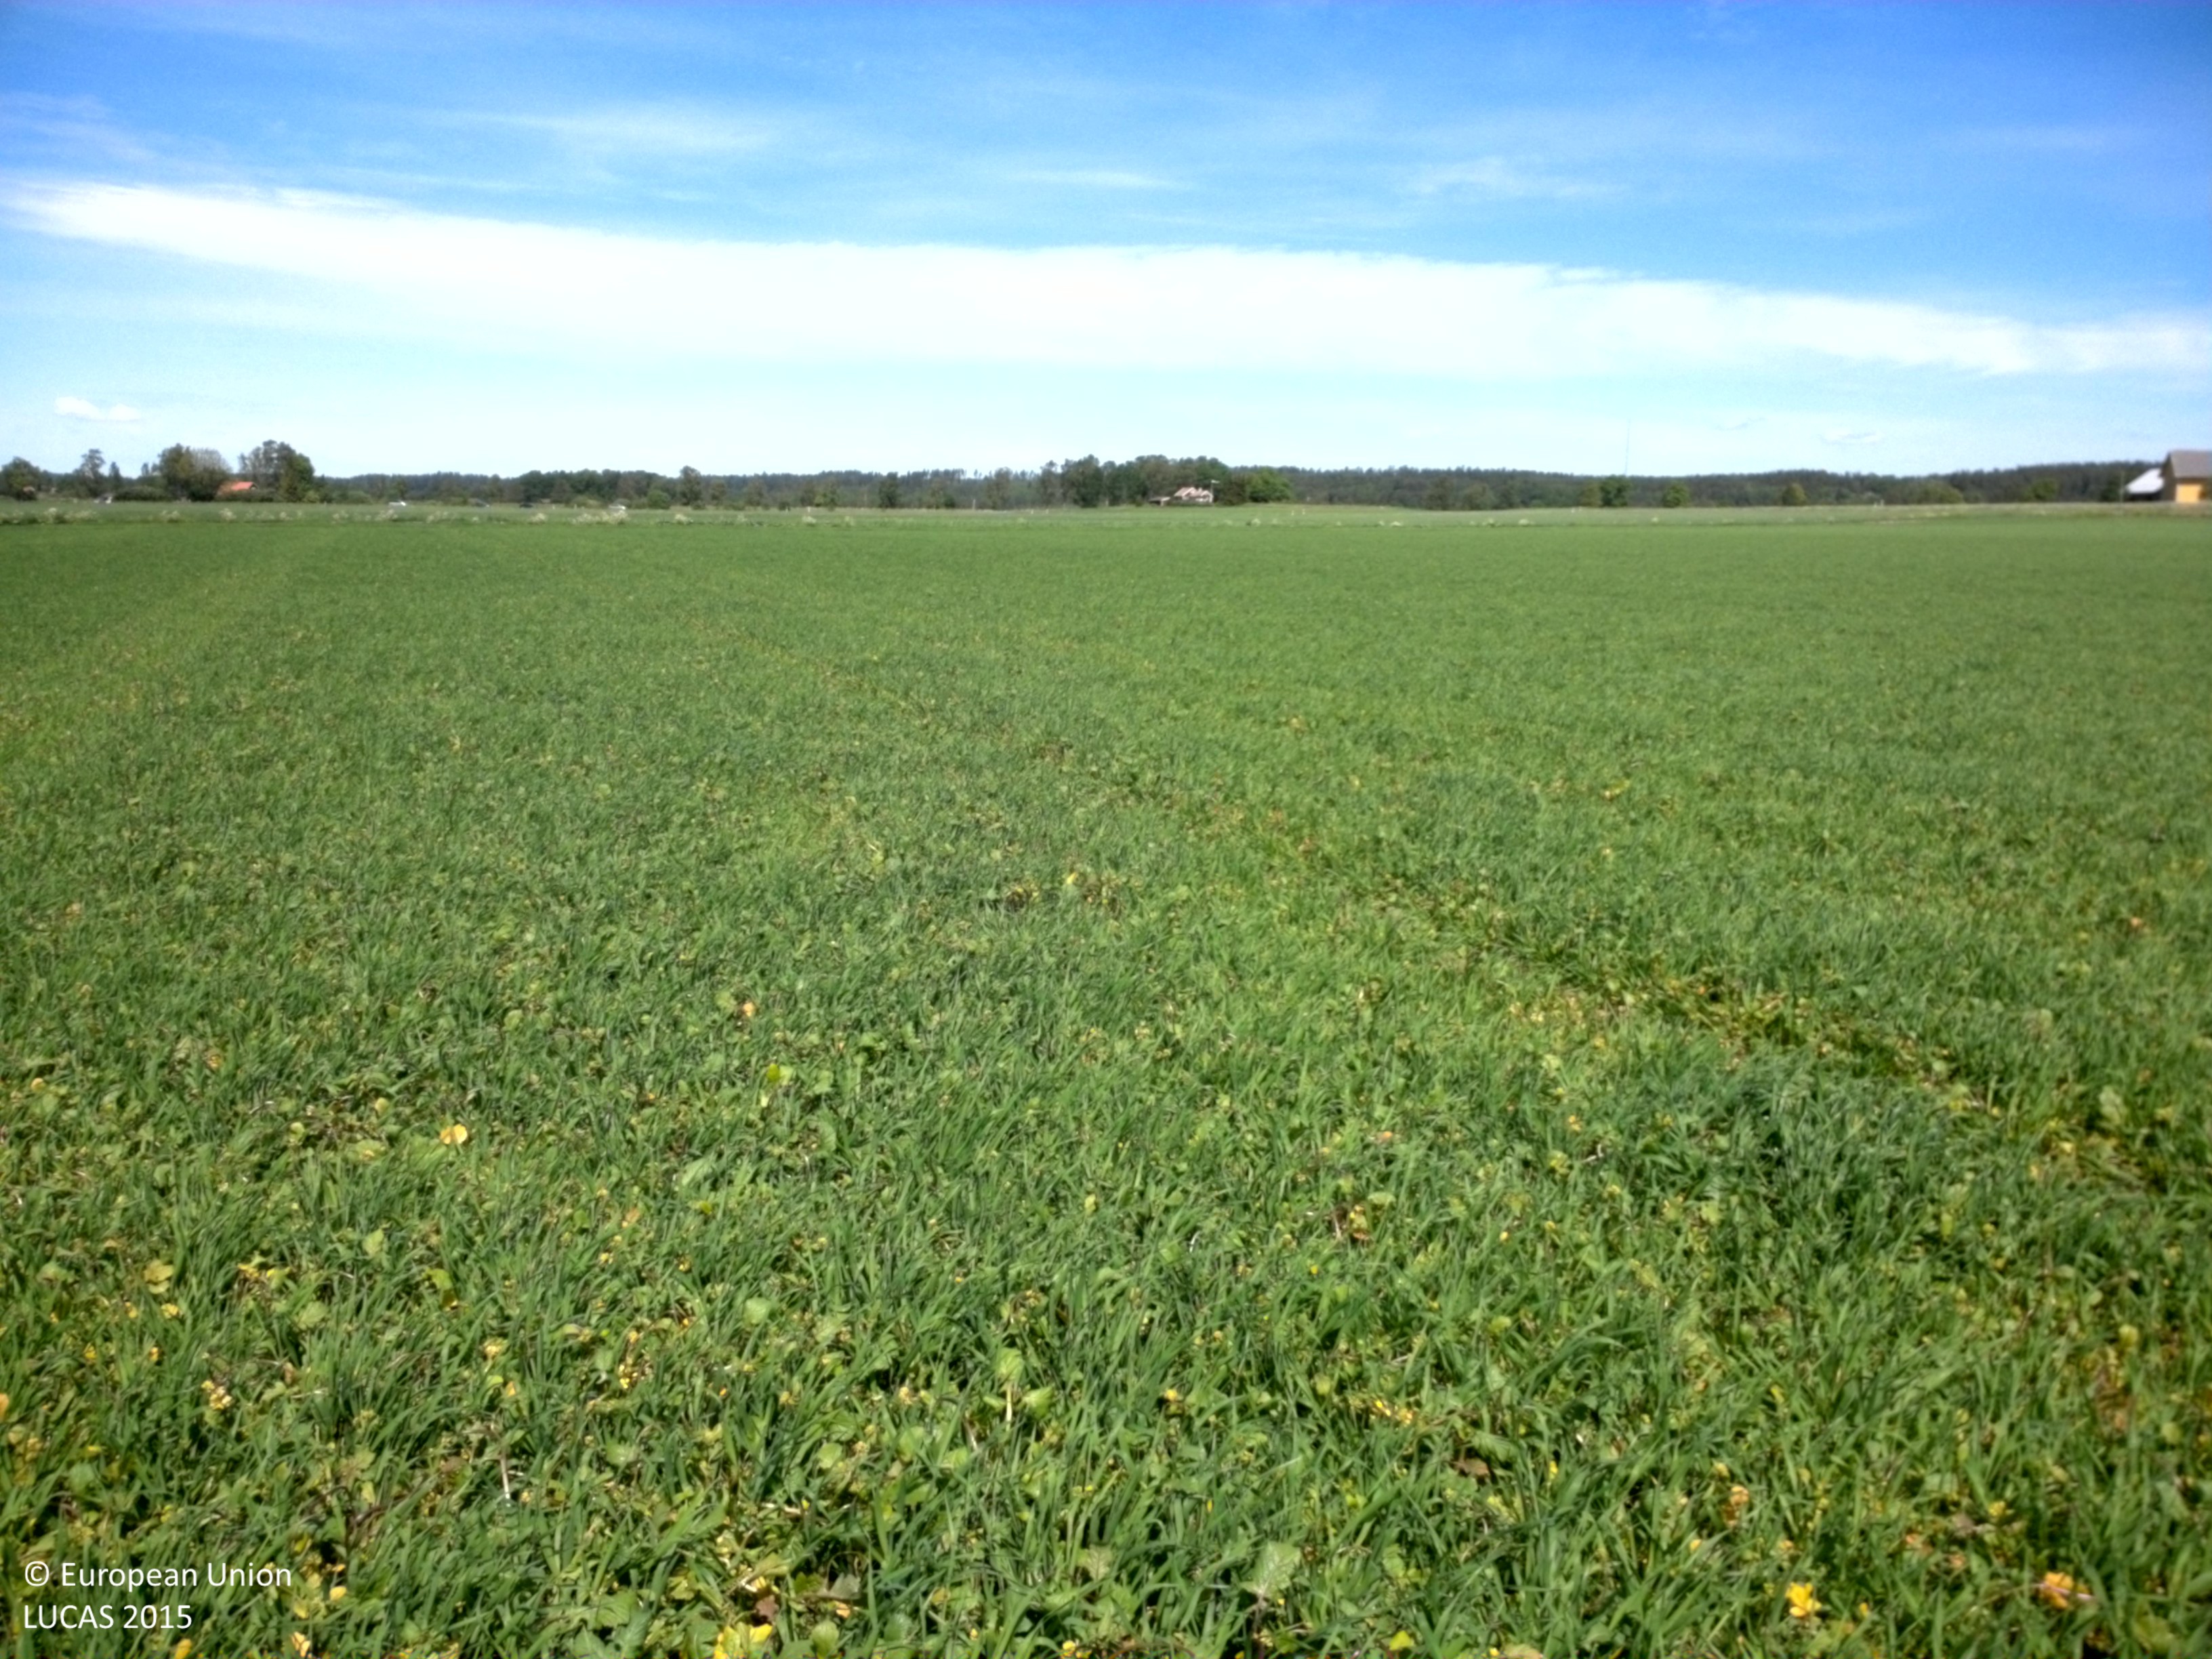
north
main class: Cropland
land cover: Barley
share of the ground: > 75 %
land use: Agriculture (excluding fallow land and kitchen gardens)
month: June
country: SE
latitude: 58.5257
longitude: 15.4031
